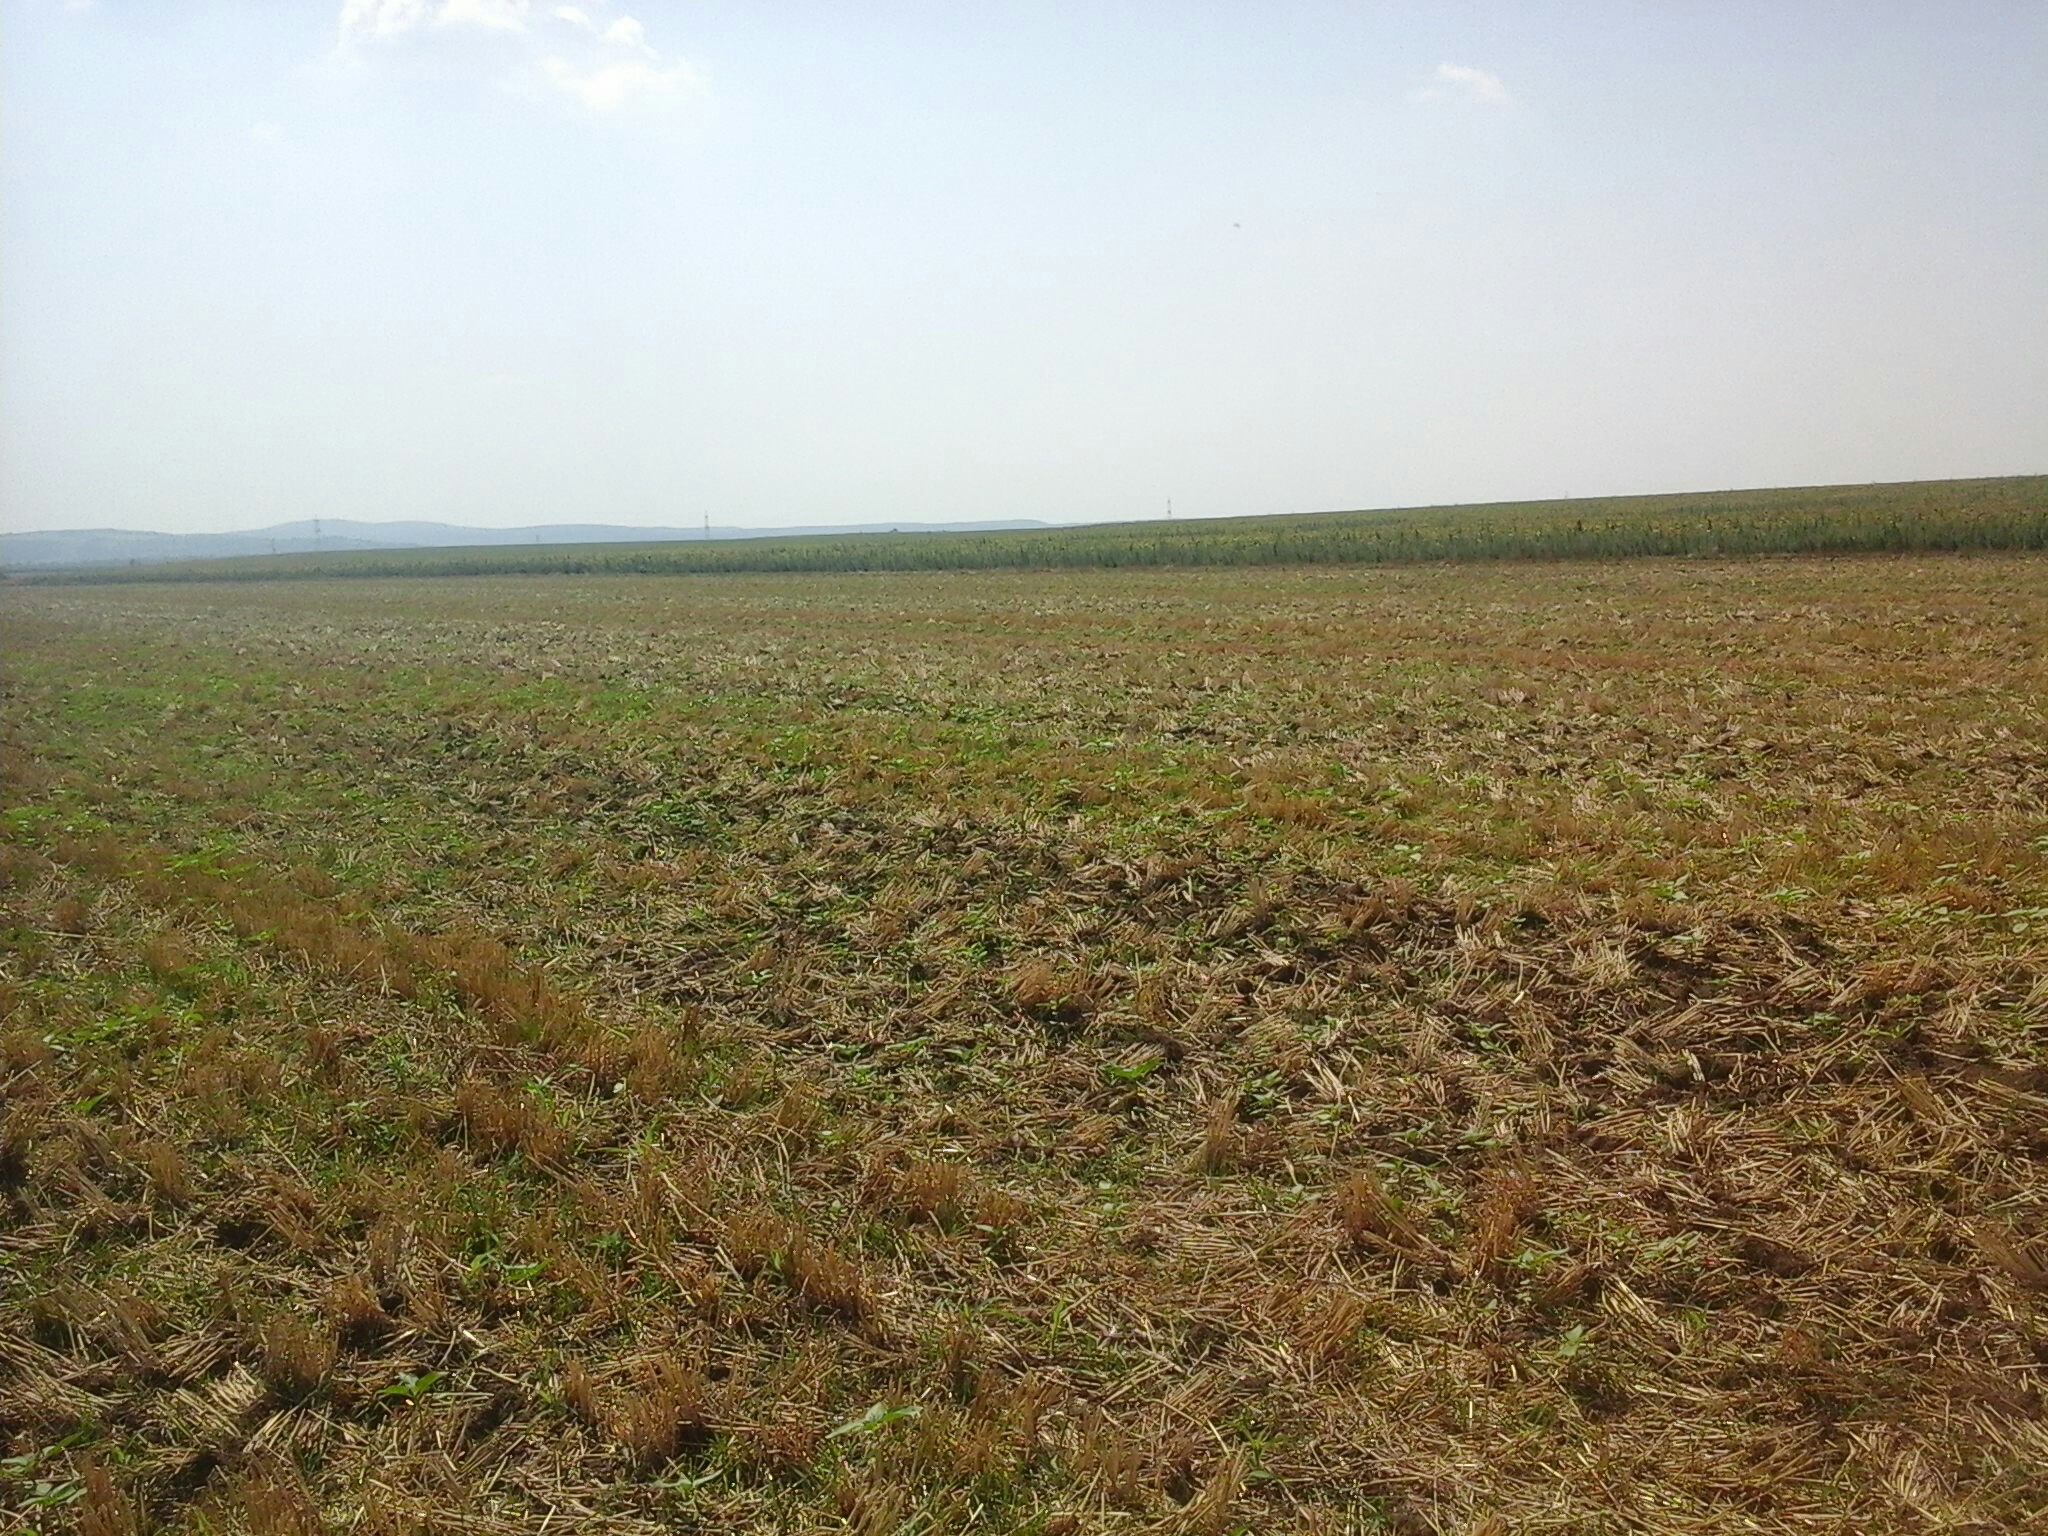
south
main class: Cropland
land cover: Common wheat
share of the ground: < 10 %
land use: Agriculture (excluding fallow land and kitchen gardens)
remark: Harvested field
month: August
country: HU
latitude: 47.3479
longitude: 18.5516
